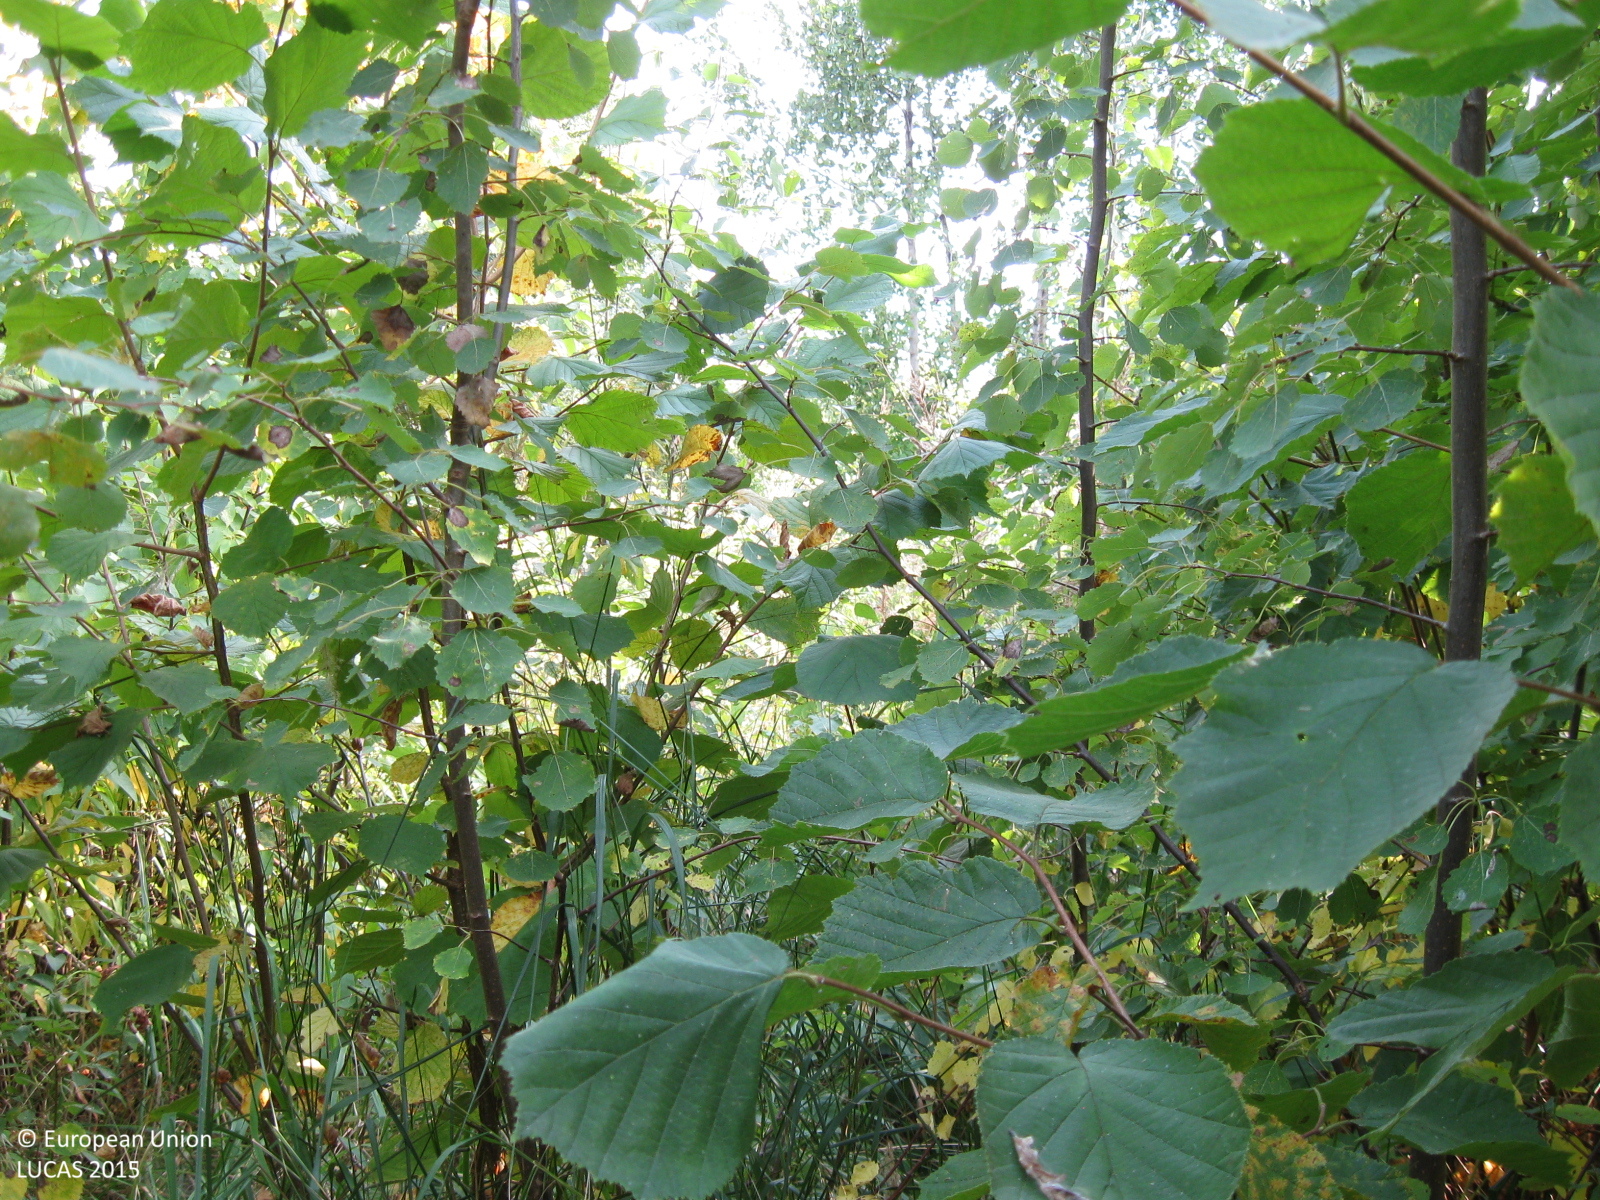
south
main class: Woodland
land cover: Broadleaved woodland
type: non-riverine alder, birch or aspen forest
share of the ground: > 75 %
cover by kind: broadleaved forest trees 80 %, herbaceous plants 20 %
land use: Forestry
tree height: < 5 m
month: August
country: LT
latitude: 55.5987
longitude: 22.9715
